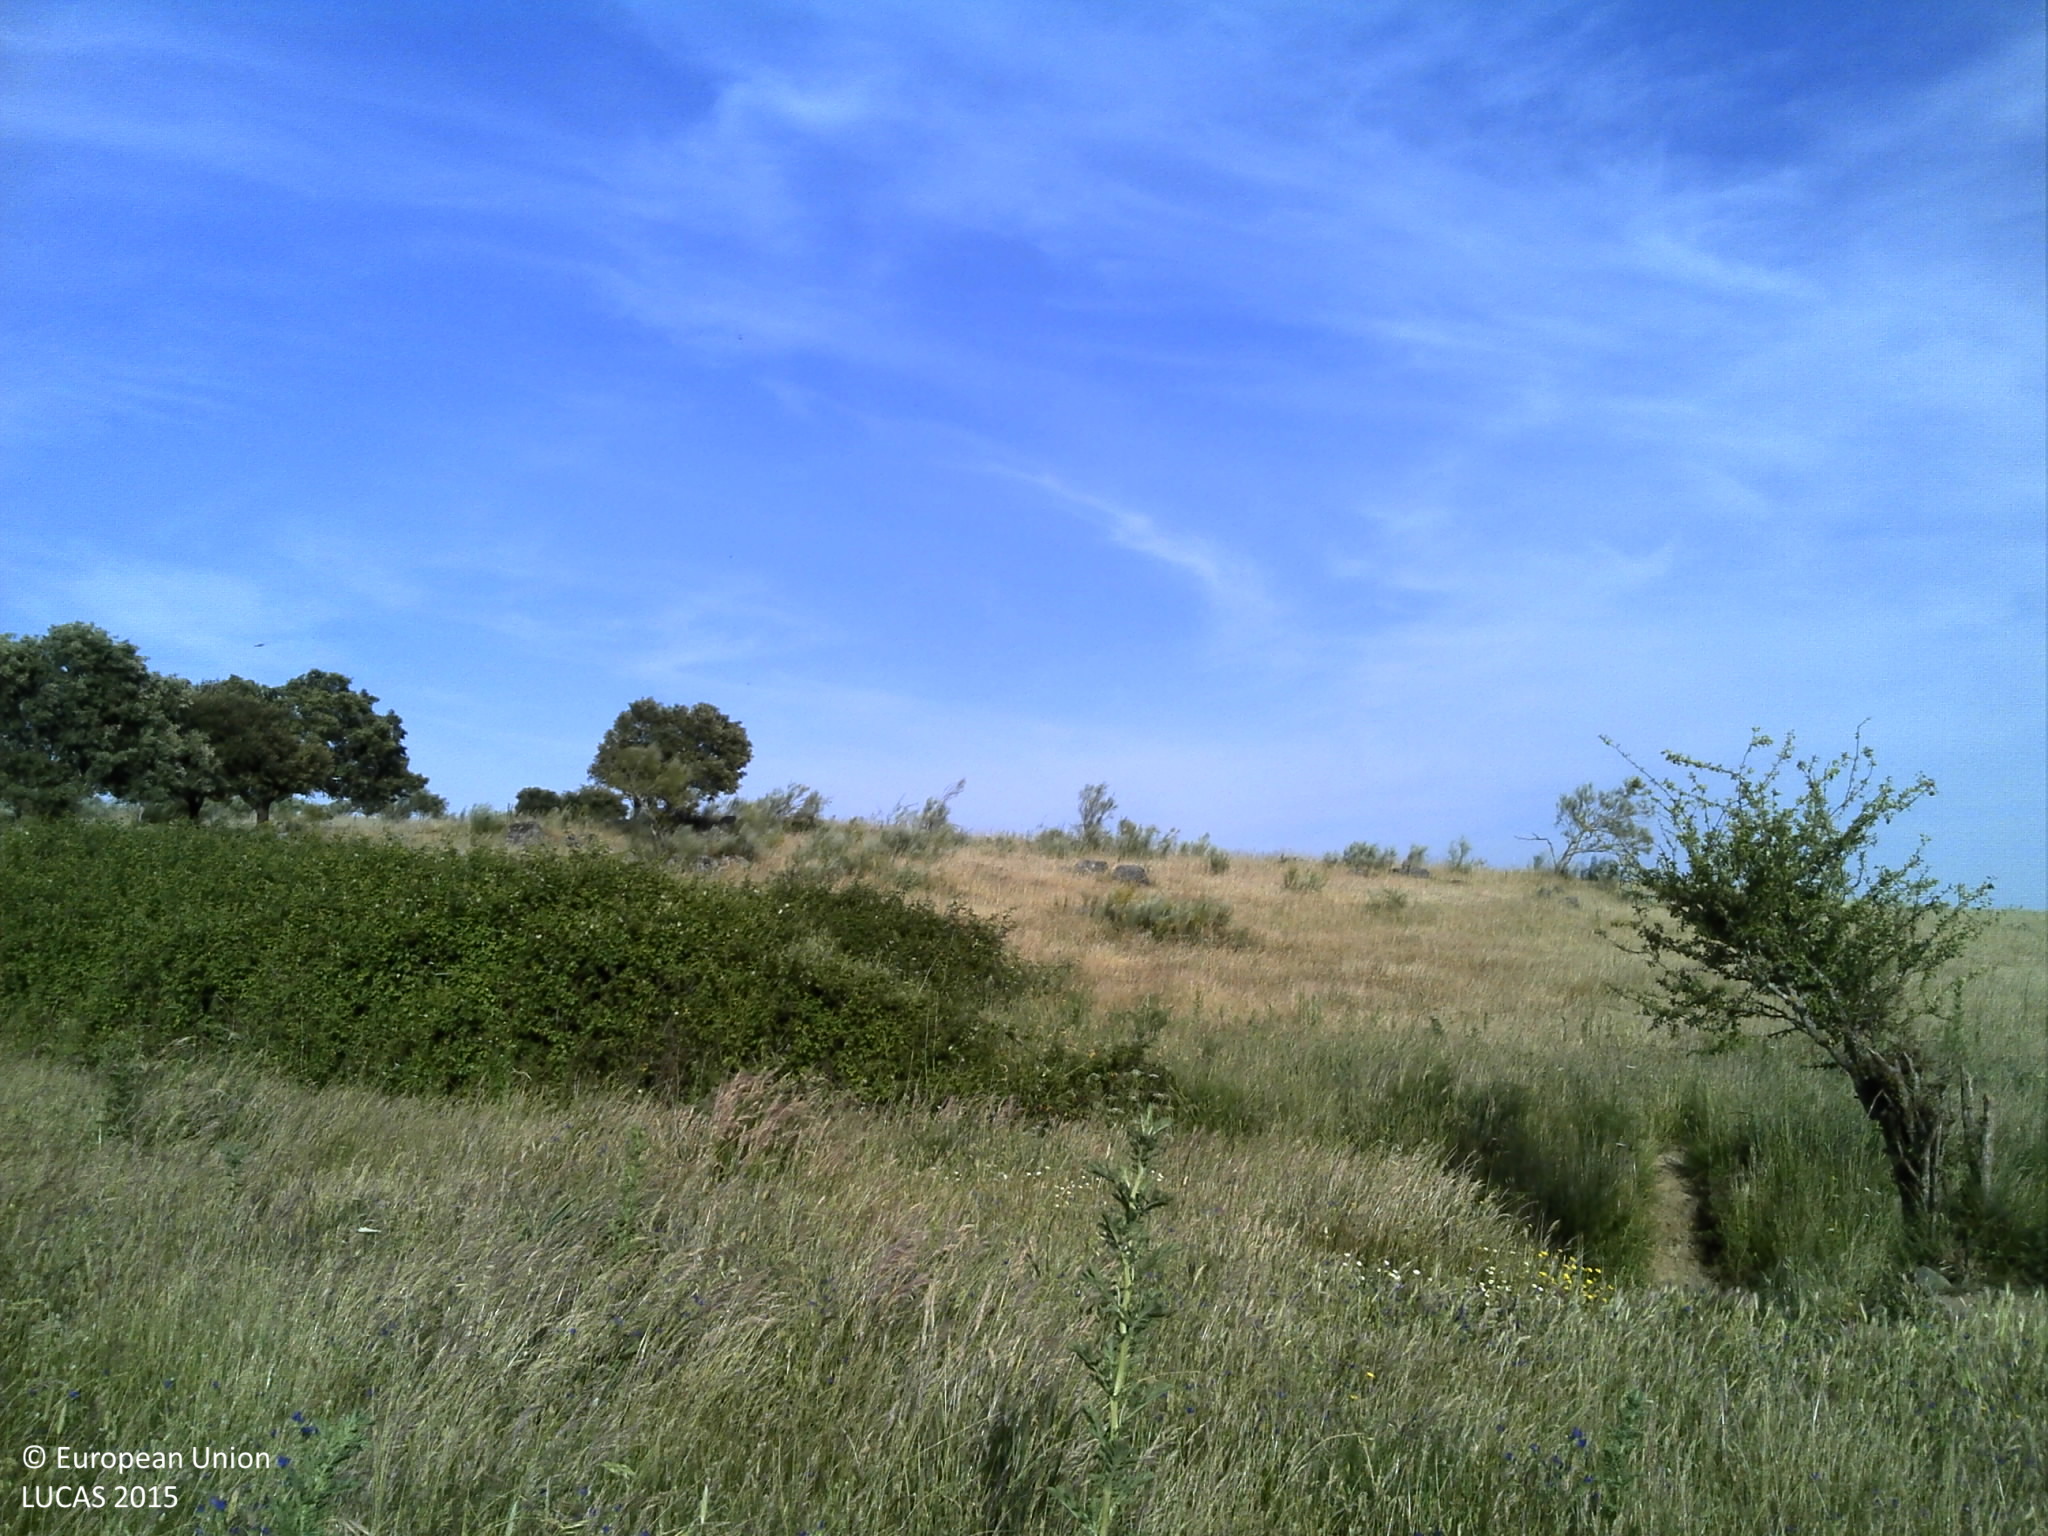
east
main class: Grassland
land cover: Grassland without tree/shrub cover
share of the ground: > 75 %
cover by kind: herbaceous plants 90 %, unconsolidated bare surface 10 %
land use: Agriculture (excluding fallow land and kitchen gardens)
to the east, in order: Grassland without tree/shrub cover; Shrubland without tree cover; Rivers and streams; Shrubland without tree cover; Grassland with sparse tree/shrub cover; Fences; Grassland with sparse tree/shrub cover; Shrubland with sparse tree cover; Other bare soil; Grassland with sparse tree/shrub cover
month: May
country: PT
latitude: 39.1659
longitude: -7.6718
